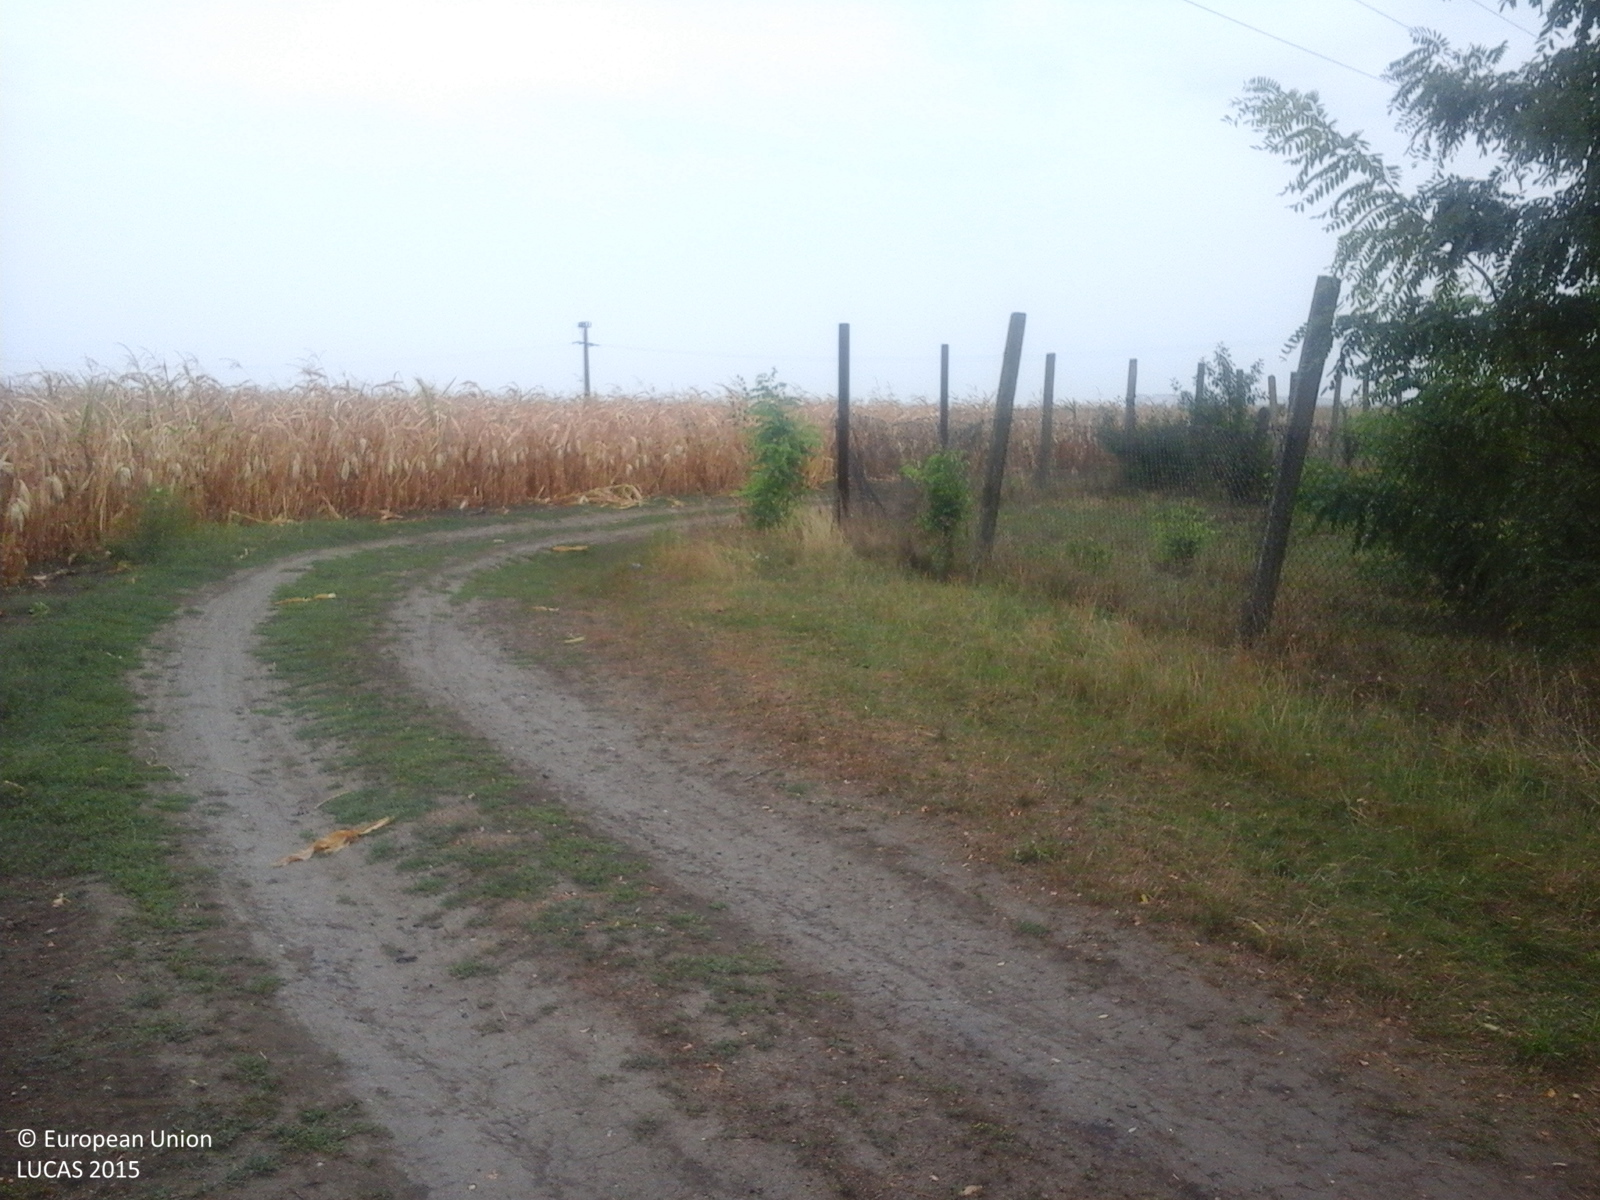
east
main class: Cropland
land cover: Maize
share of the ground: > 75 %
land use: Agriculture (excluding fallow land and kitchen gardens)
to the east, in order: Maize; Electric lines; Maize; Tracks; Grassland without tree/shrub cover; Inland fresh running water; Electric lines; Maize
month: September
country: RO
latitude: 47.7452
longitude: 22.5020
